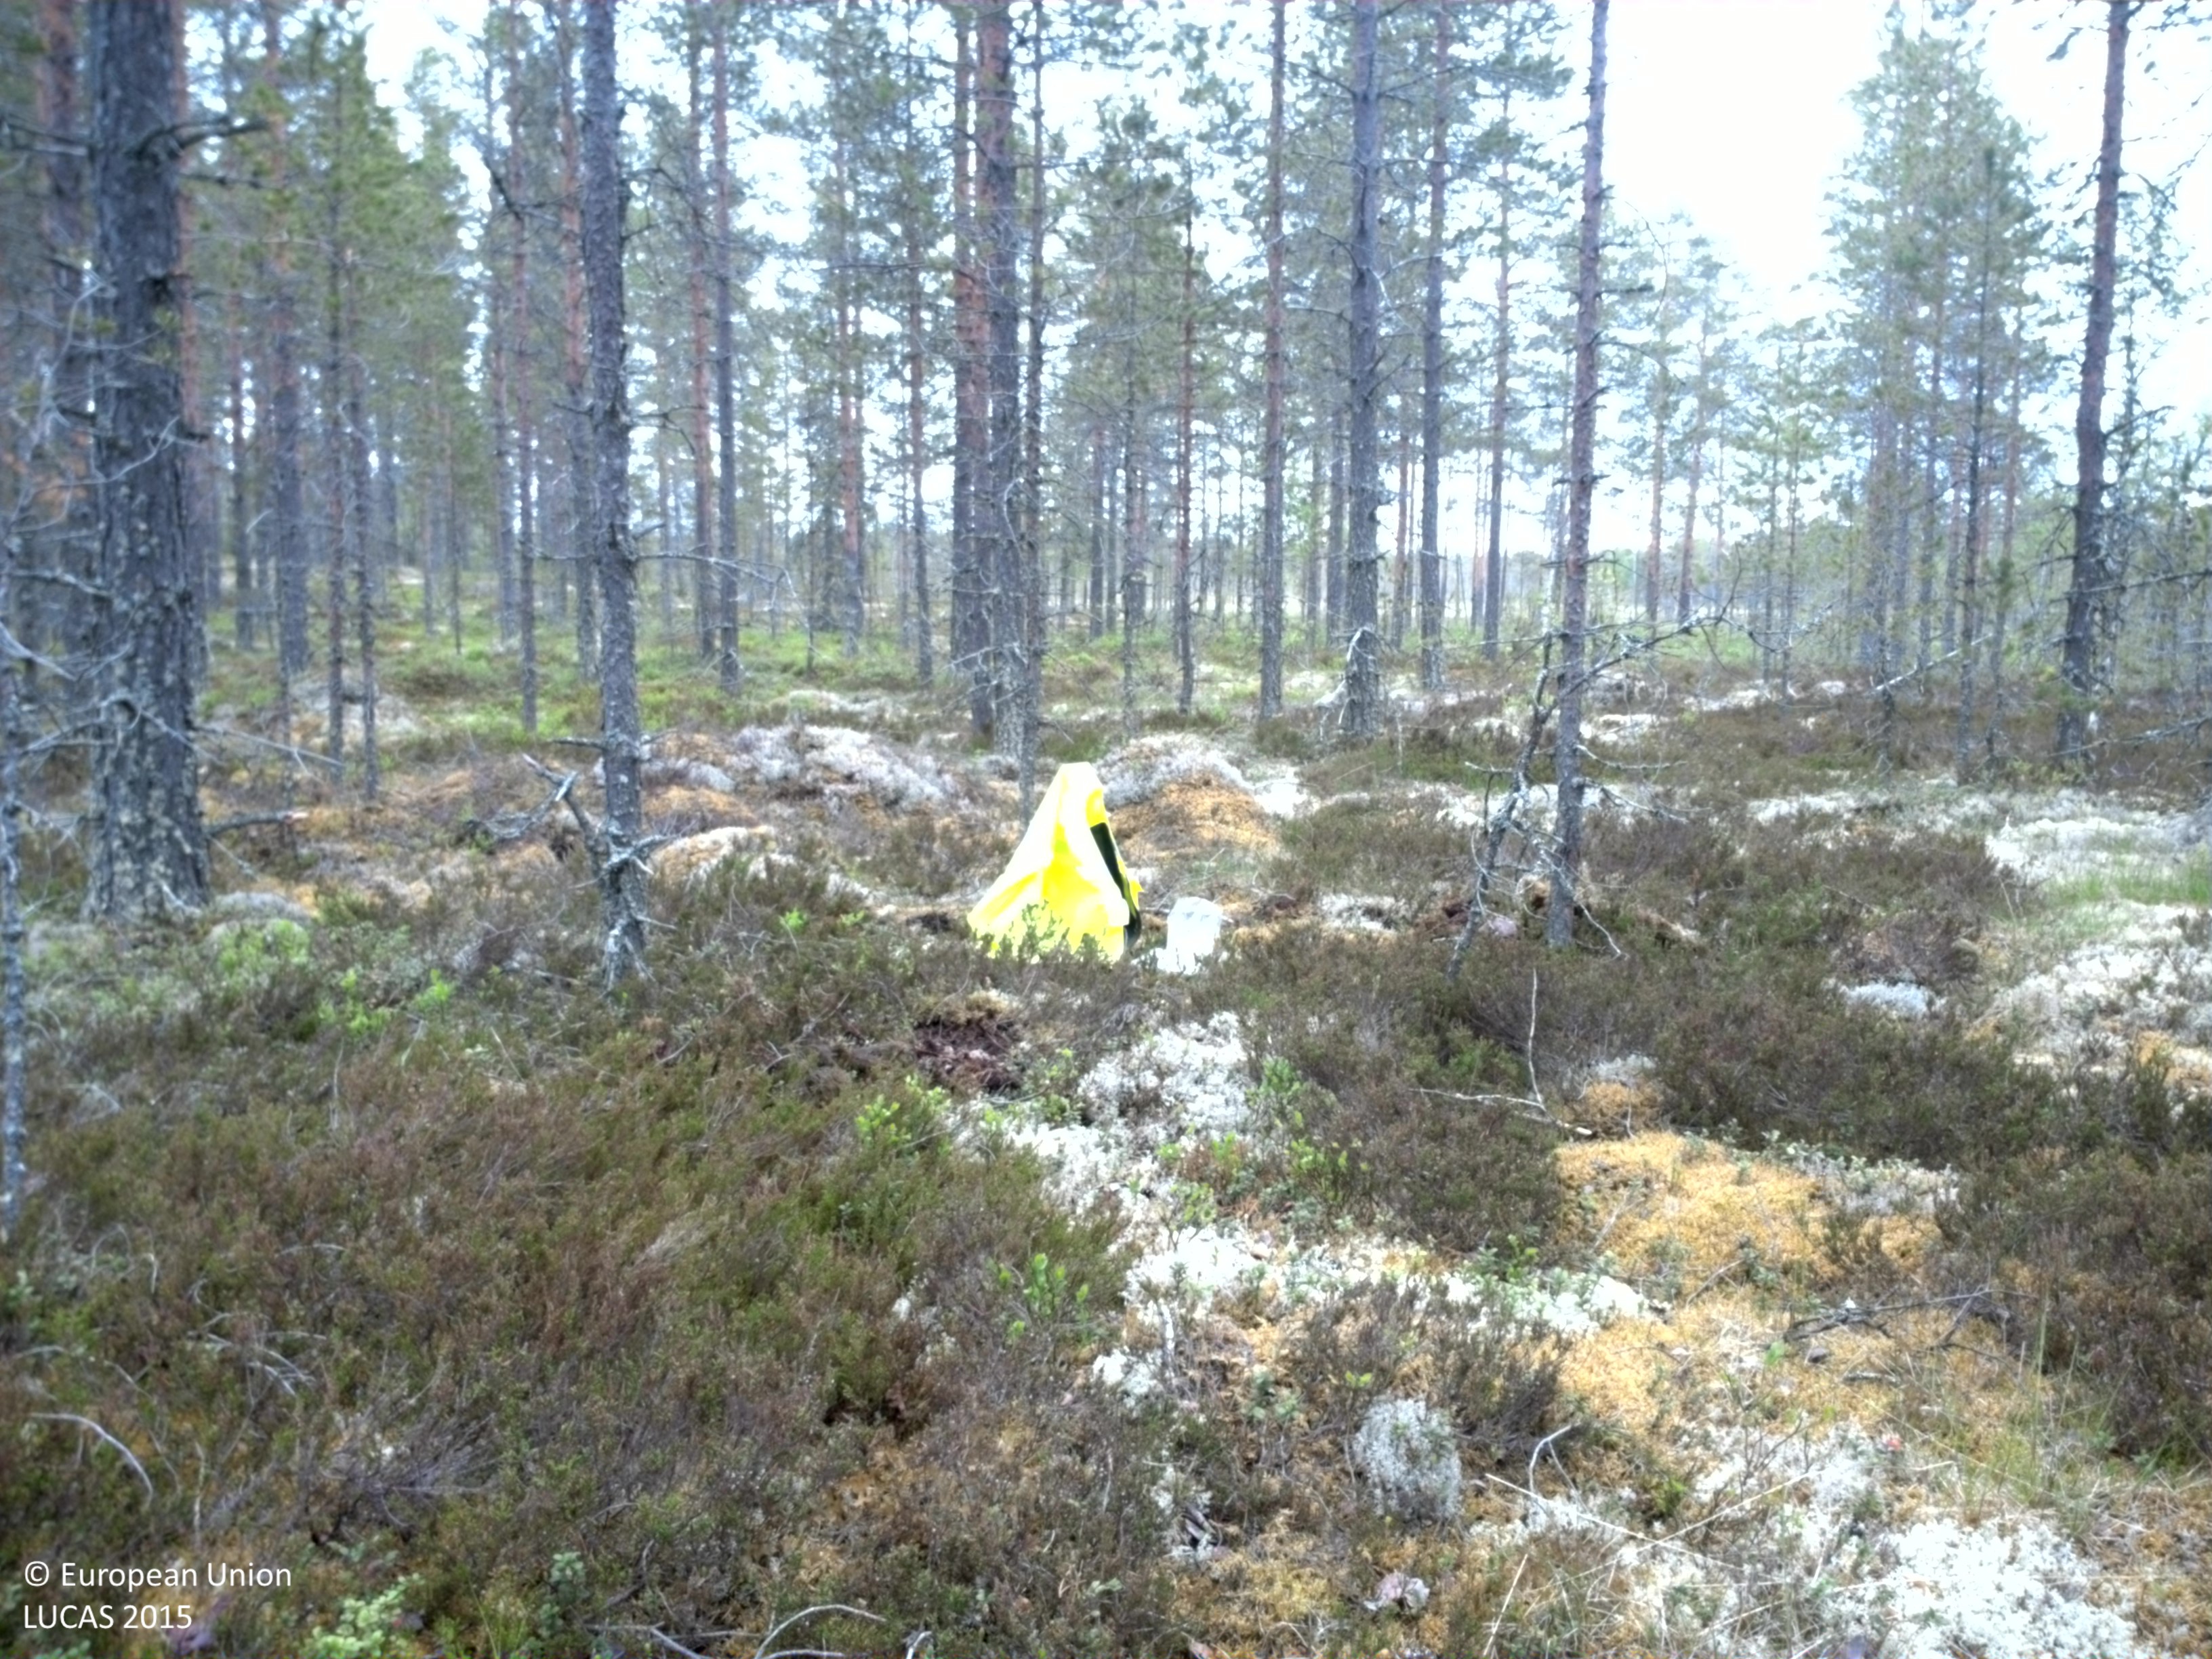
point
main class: Woodland
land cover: Pine dominated coniferous woodland
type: boreal forest
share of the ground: 50 - 75 %
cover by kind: coniferous forest trees 60 %, herbaceous plants 15 %, lichens and mosses 15 %, broadleaved forest trees 10 %
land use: Forestry
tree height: > 5 m
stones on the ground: < 10 %
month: June
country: SE
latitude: 61.1979
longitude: 13.6161
